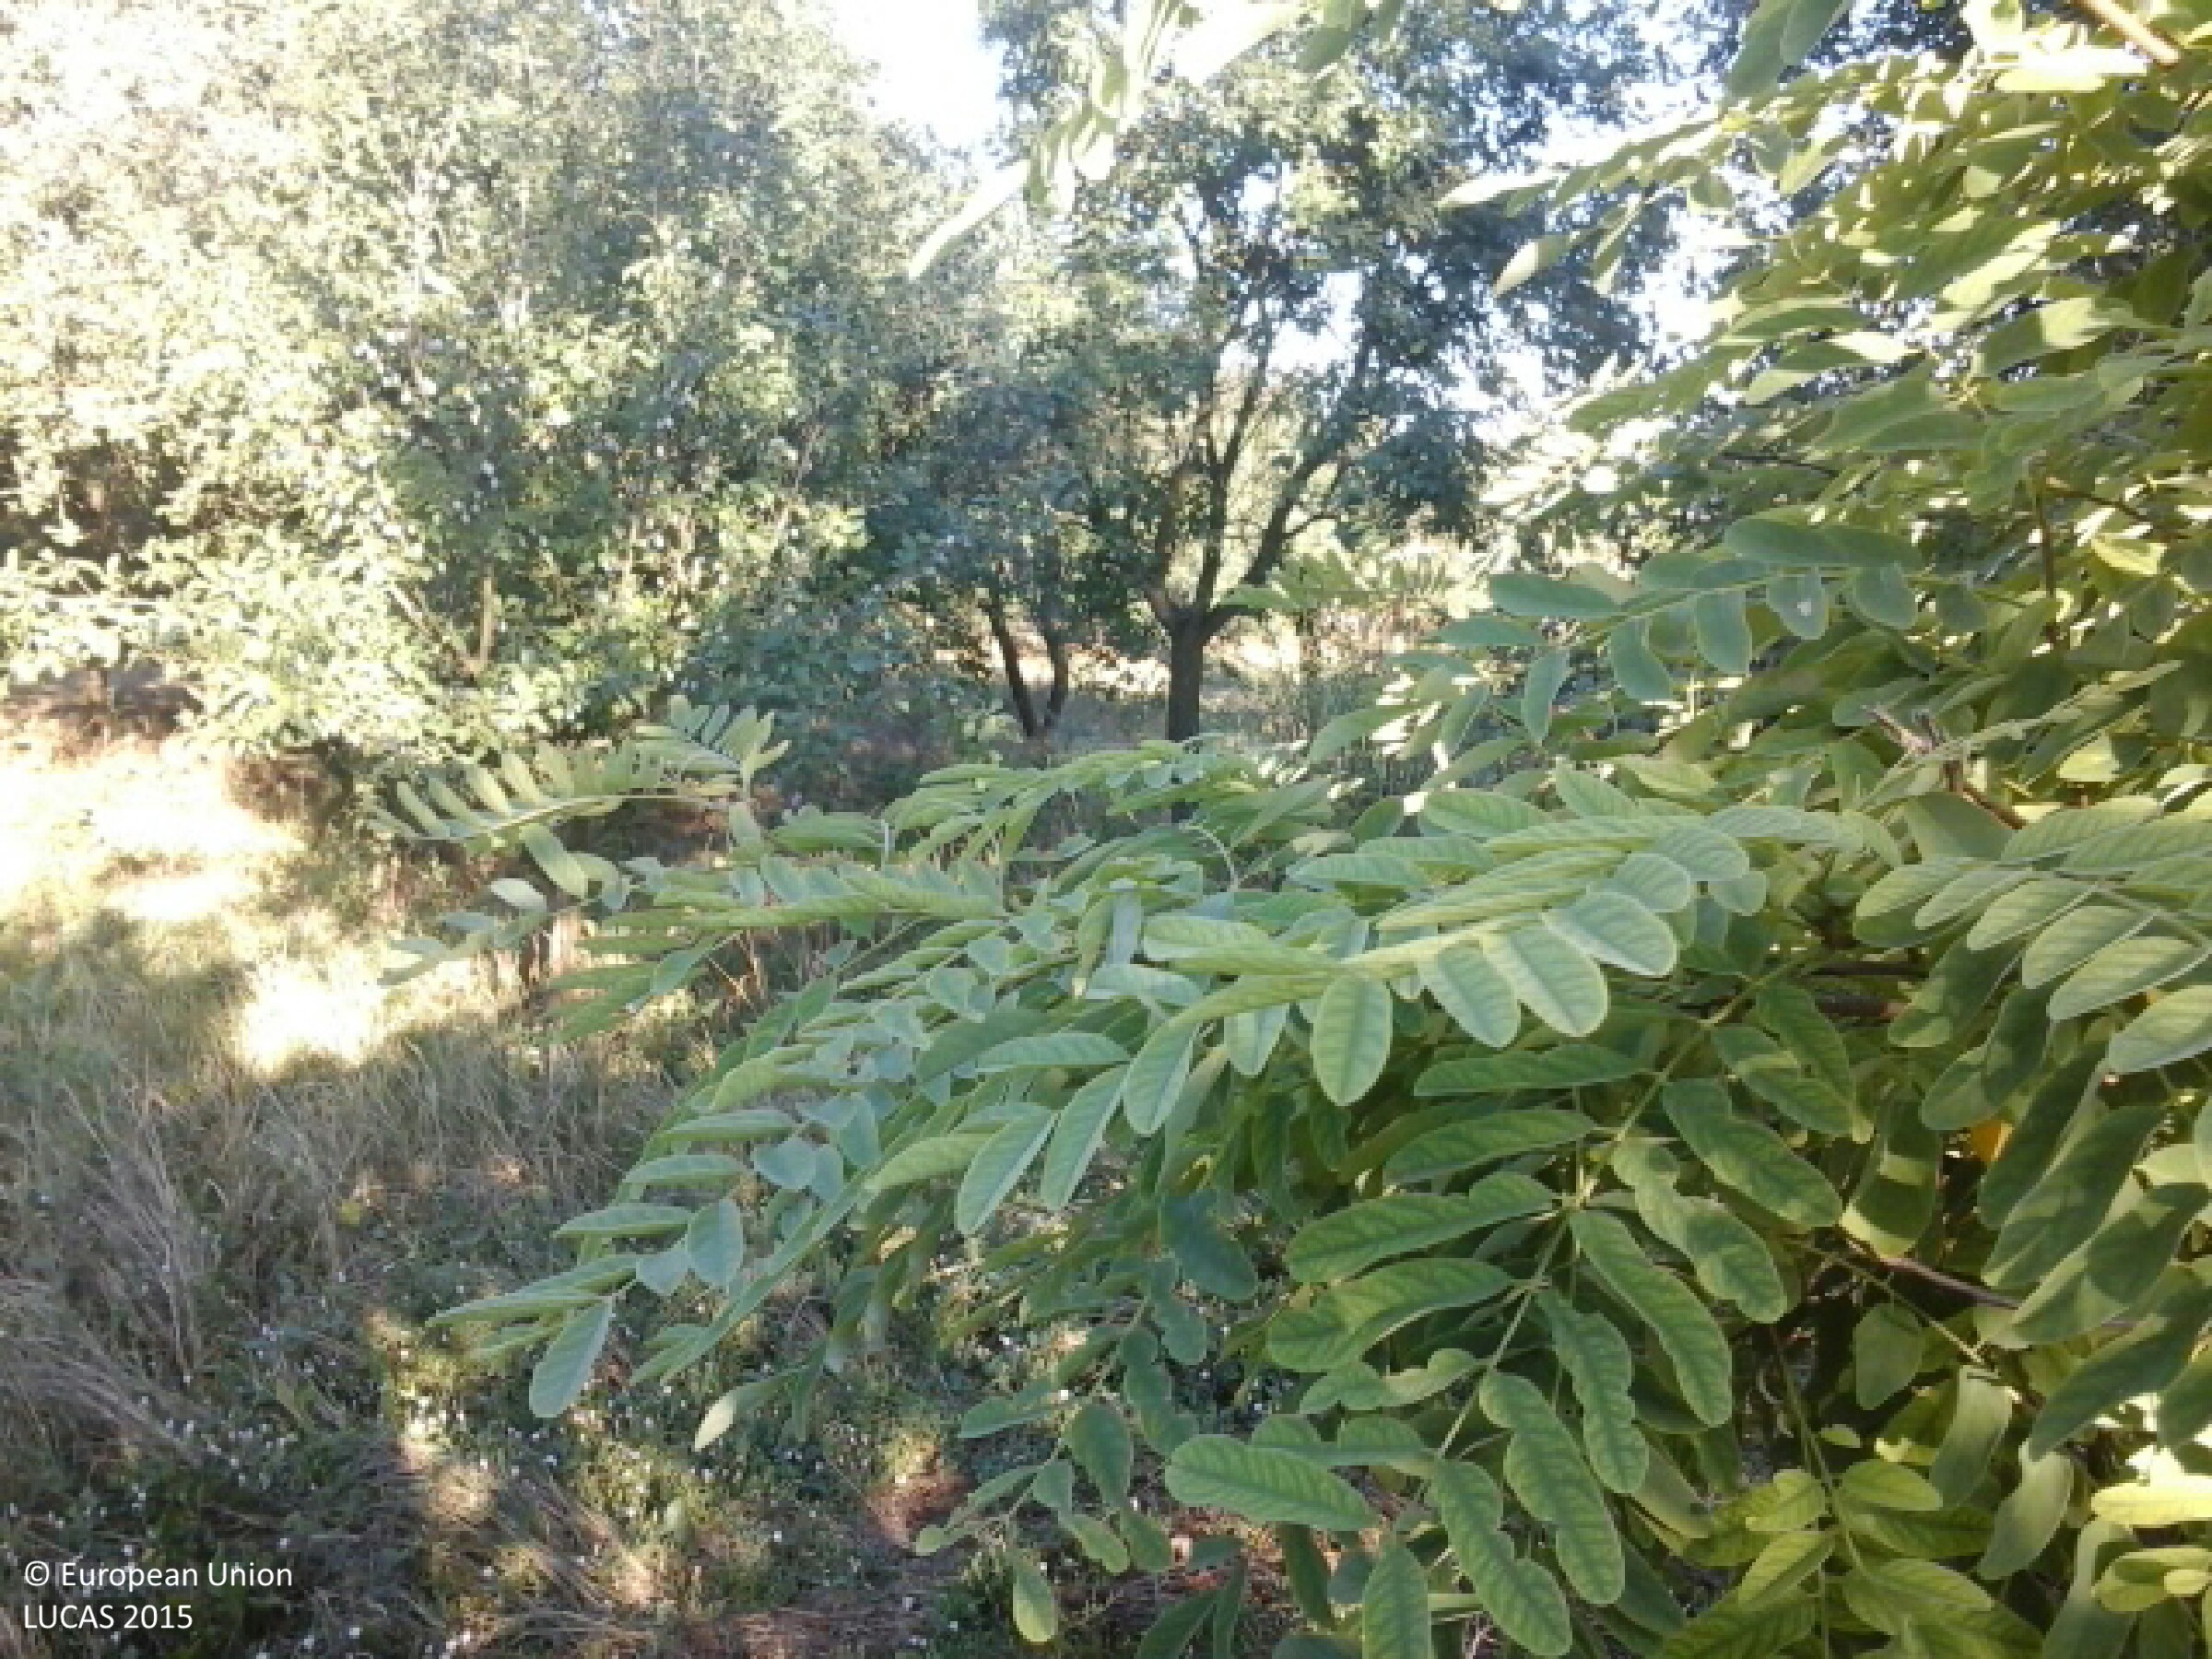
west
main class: Grassland
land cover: Grassland with sparse tree/shrub cover
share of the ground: > 75 %
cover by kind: herbaceous plants 90 %, broadleaved forest trees 5 %, shrubs 5 %
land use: Residential
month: July
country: HU
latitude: 48.2932
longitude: 21.1348
